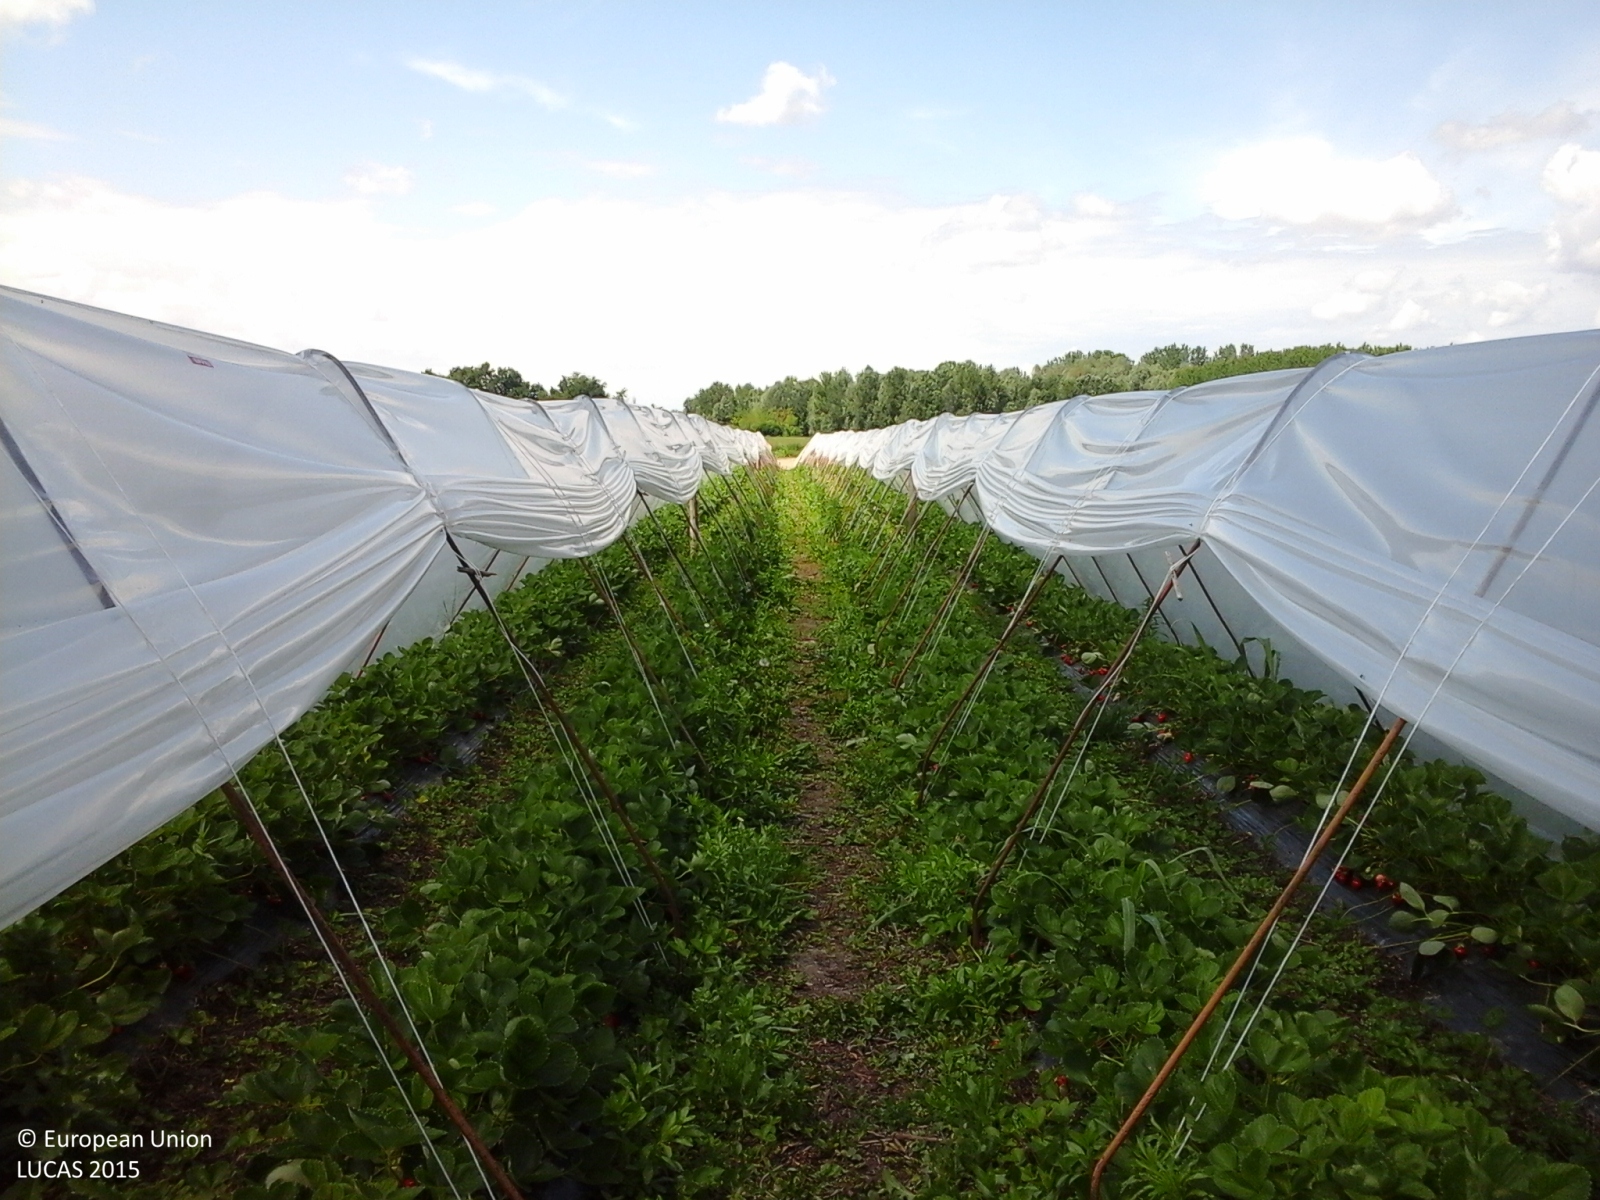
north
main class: Cropland
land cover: Strawberries
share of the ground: > 75 %
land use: Agriculture (excluding fallow land and kitchen gardens)
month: May
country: IT
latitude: 45.1647
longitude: 8.2093
